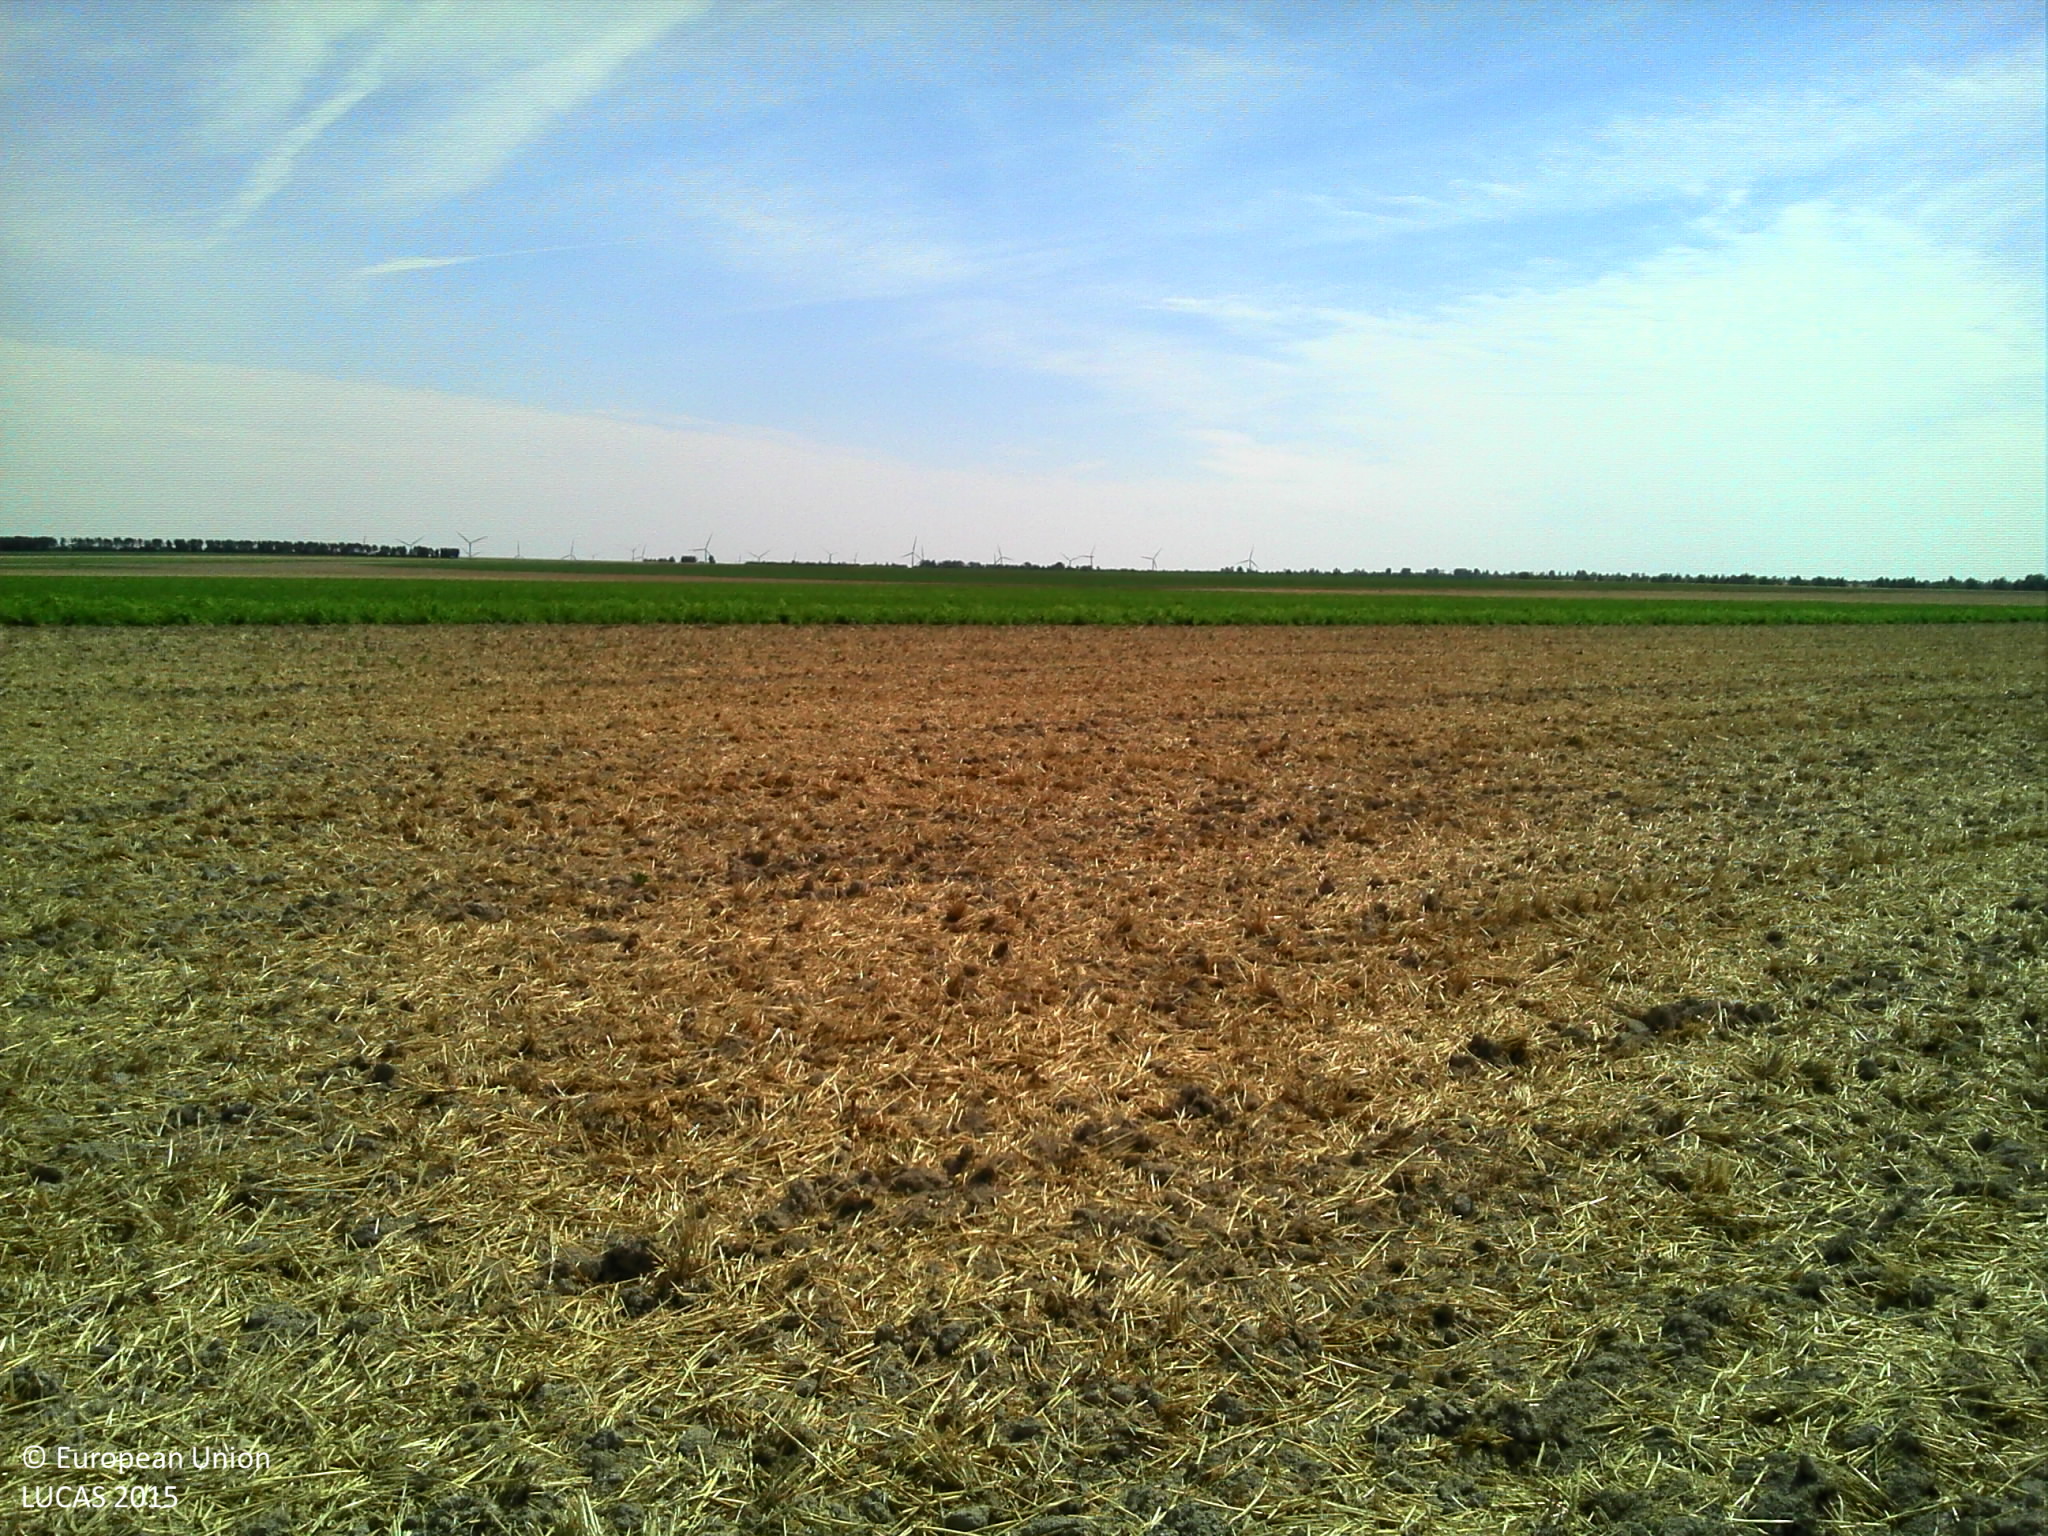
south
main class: Cropland
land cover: Common wheat
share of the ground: > 75 %
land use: Agriculture (excluding fallow land and kitchen gardens)
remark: Harvested field
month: August
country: FR
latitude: 48.9529
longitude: 4.1646
